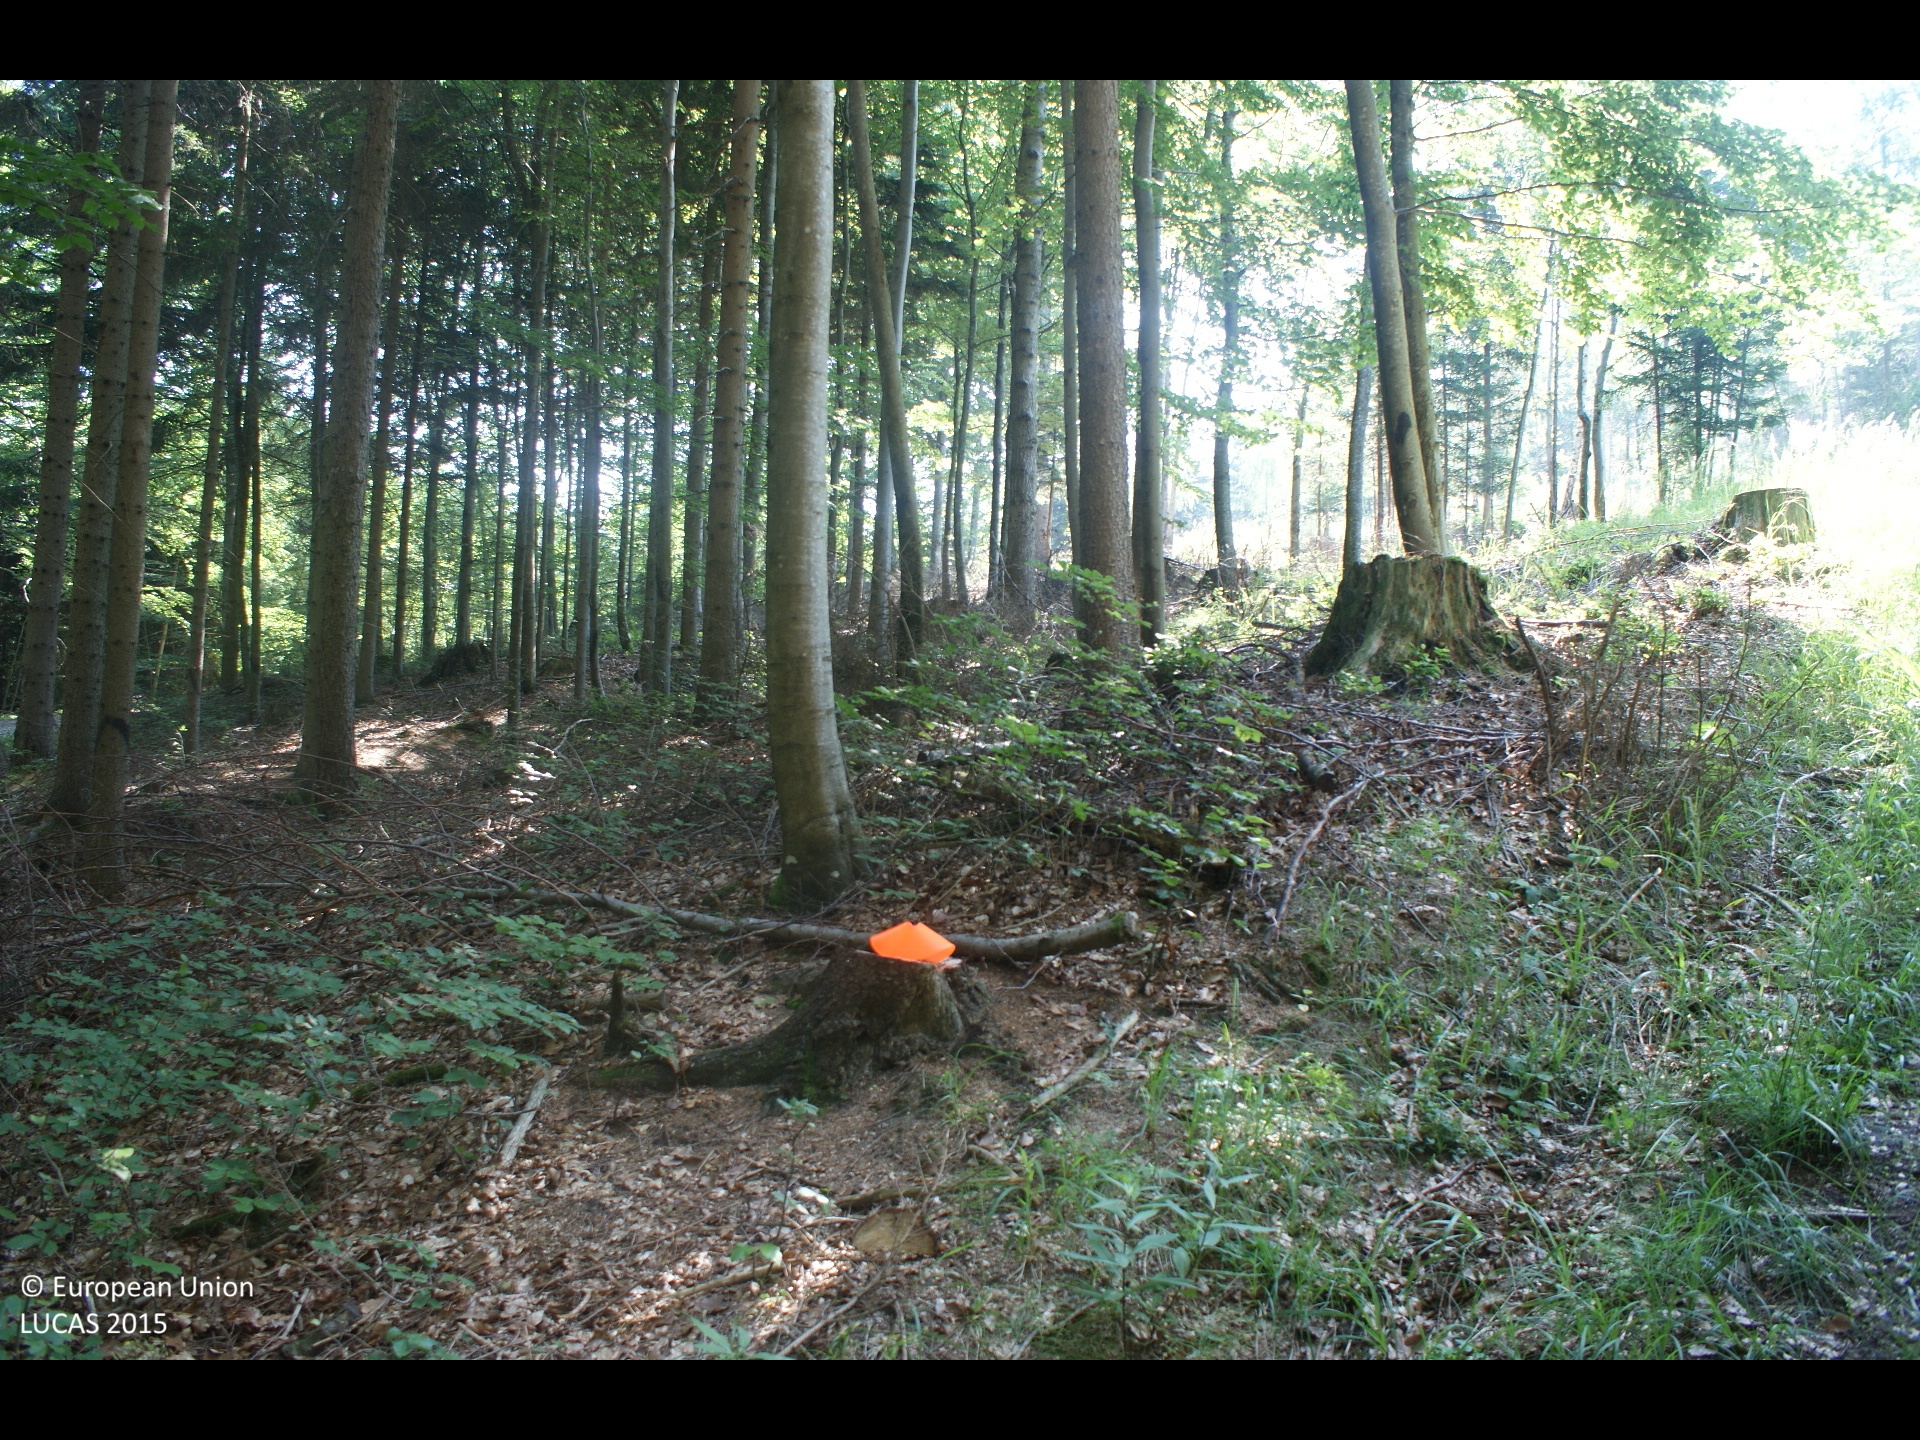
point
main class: Woodland
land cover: Spruce dominated mixed woodland
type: mountainous beech forest
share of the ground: > 75 %
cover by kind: coniferous forest trees 70 %, broadleaved forest trees 30 %
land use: Forestry
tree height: > 5 m
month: July
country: AT
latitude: 47.9288
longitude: 14.1620
